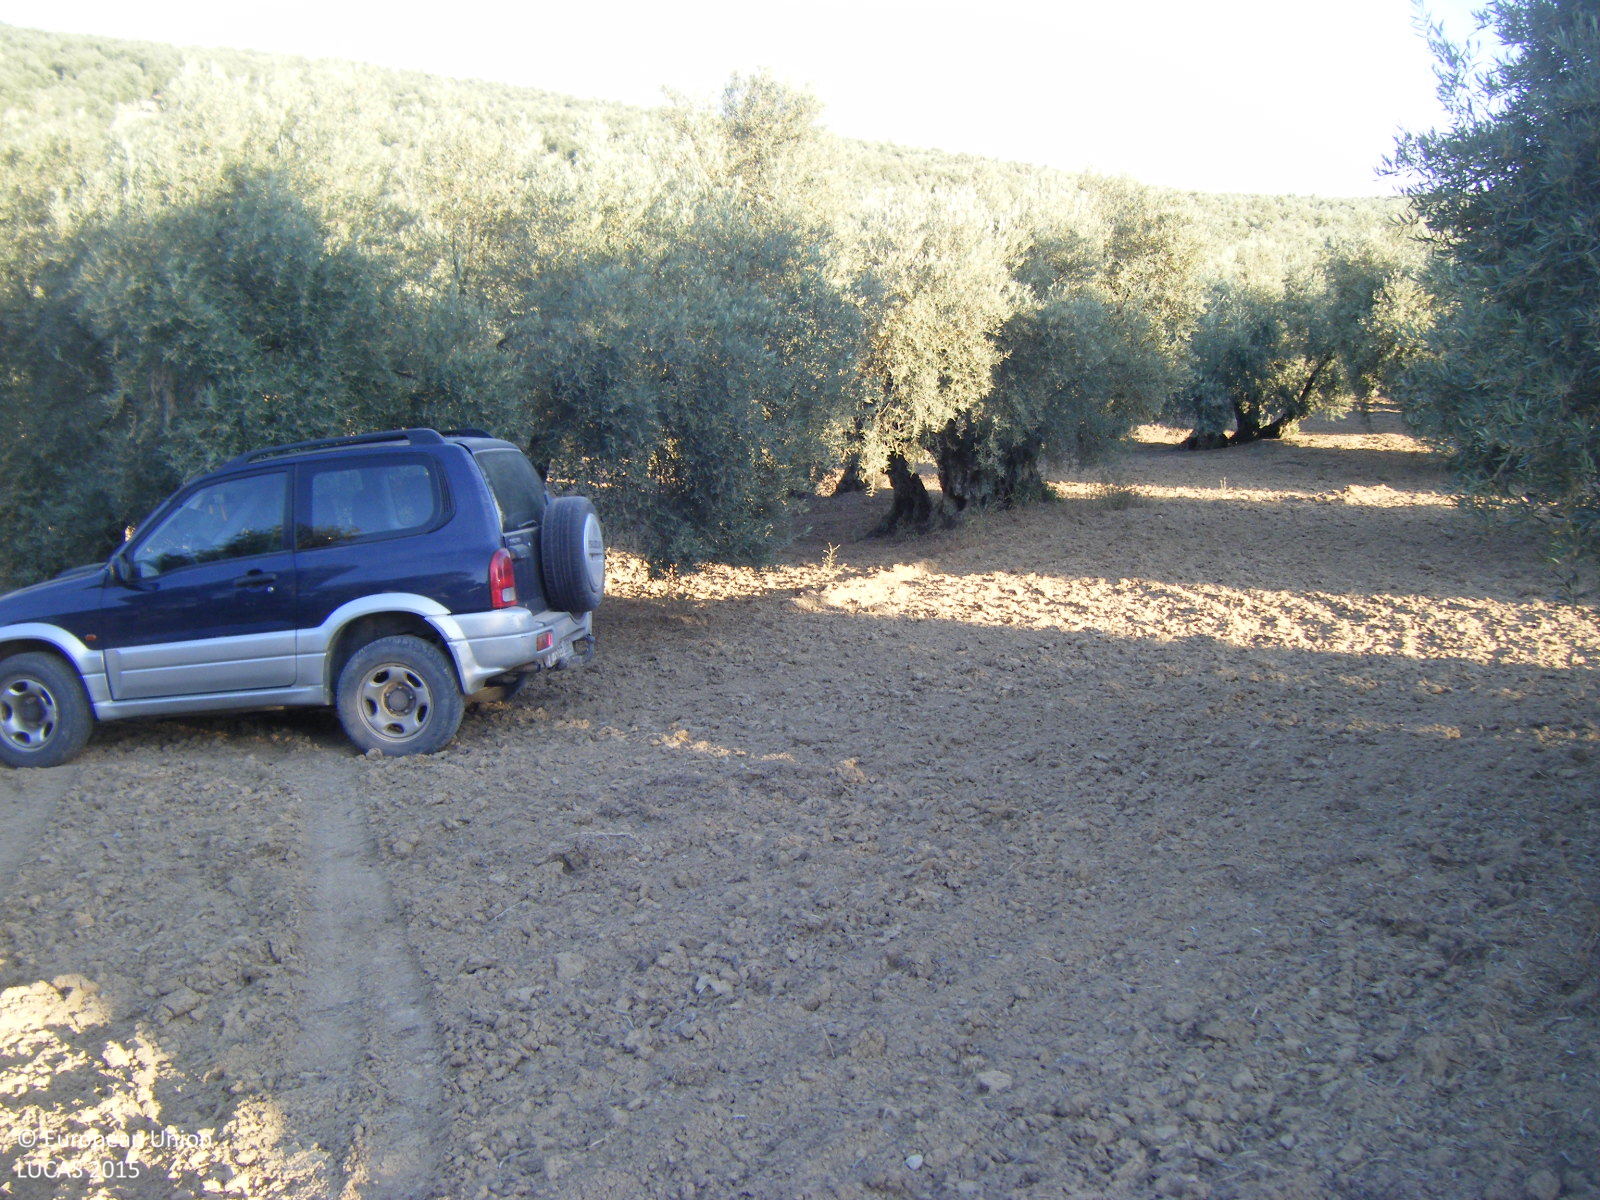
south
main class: Cropland
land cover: Olive groves
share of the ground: 25 - 50 %
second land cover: Other bare soil
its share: > 75 %
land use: Agriculture (excluding fallow land and kitchen gardens)
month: May
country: ES
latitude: 37.2356
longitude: -4.5068
